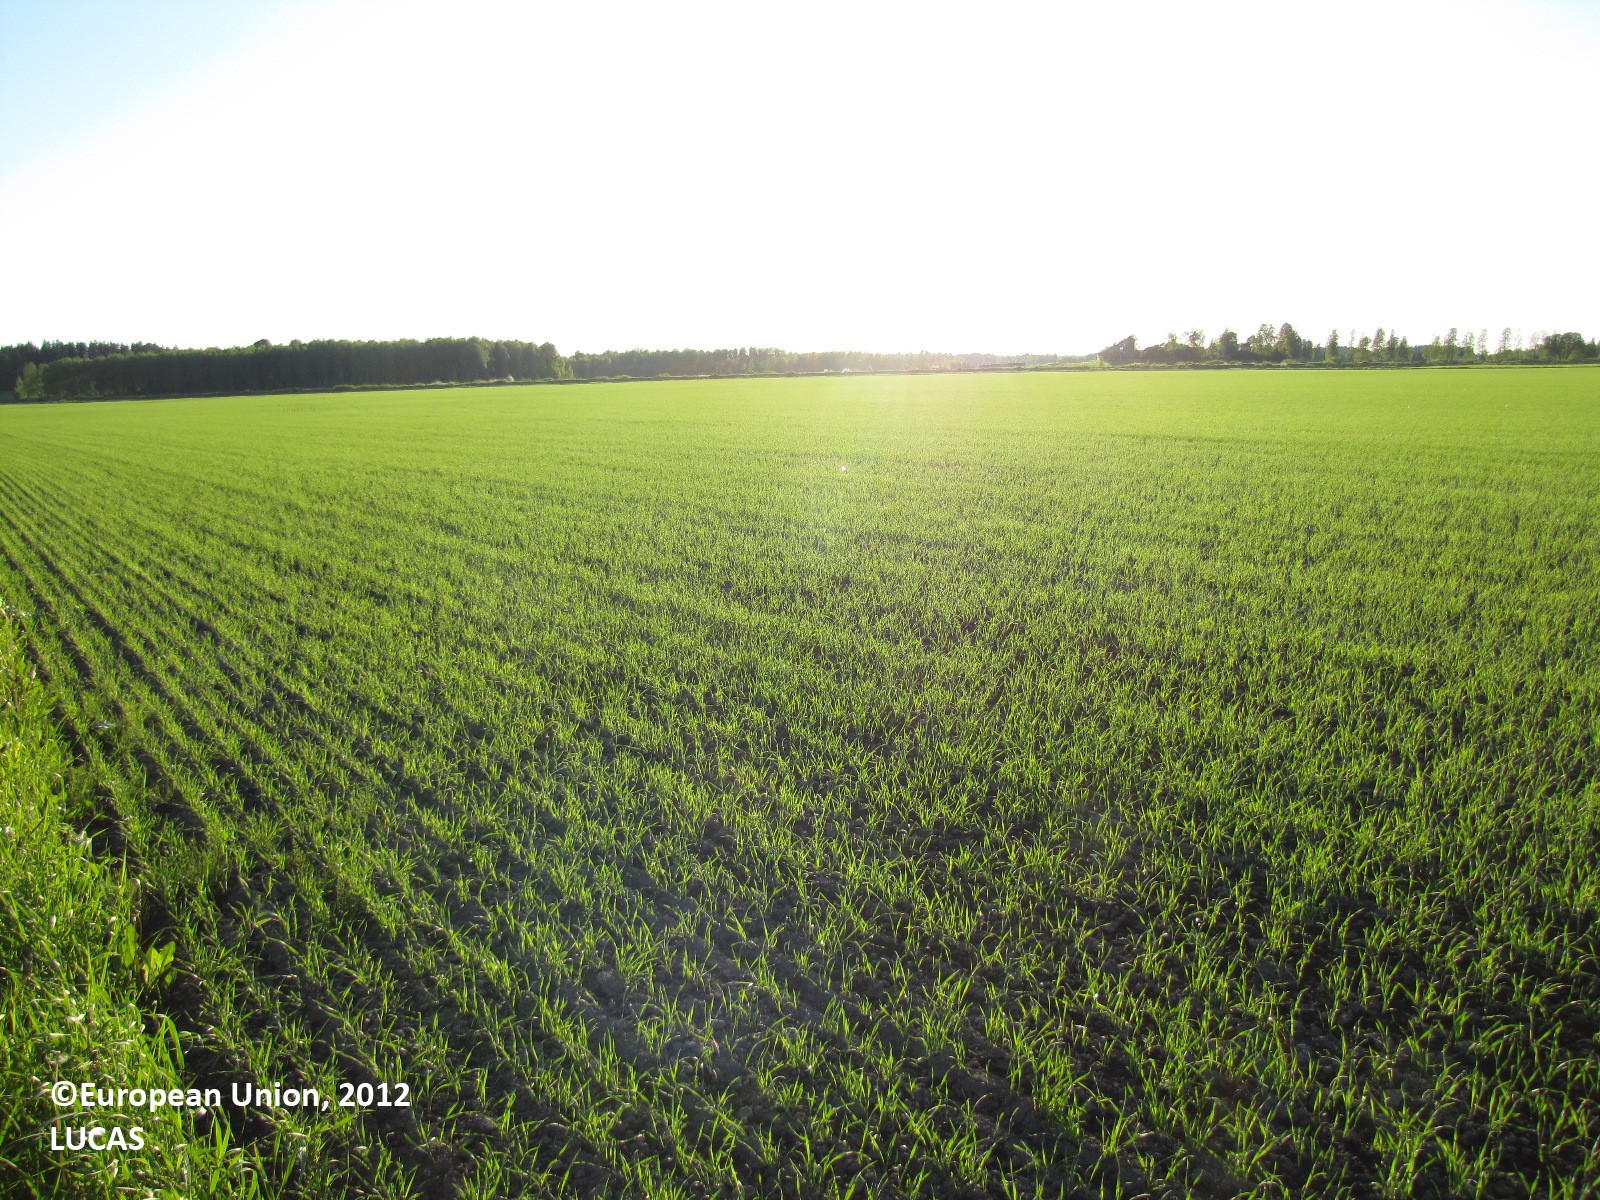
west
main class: Cropland
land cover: Common wheat
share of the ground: 25 - 50 %
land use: Agriculture (excluding fallow land and kitchen gardens)
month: June
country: FI
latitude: 61.3220
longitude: 22.9041
